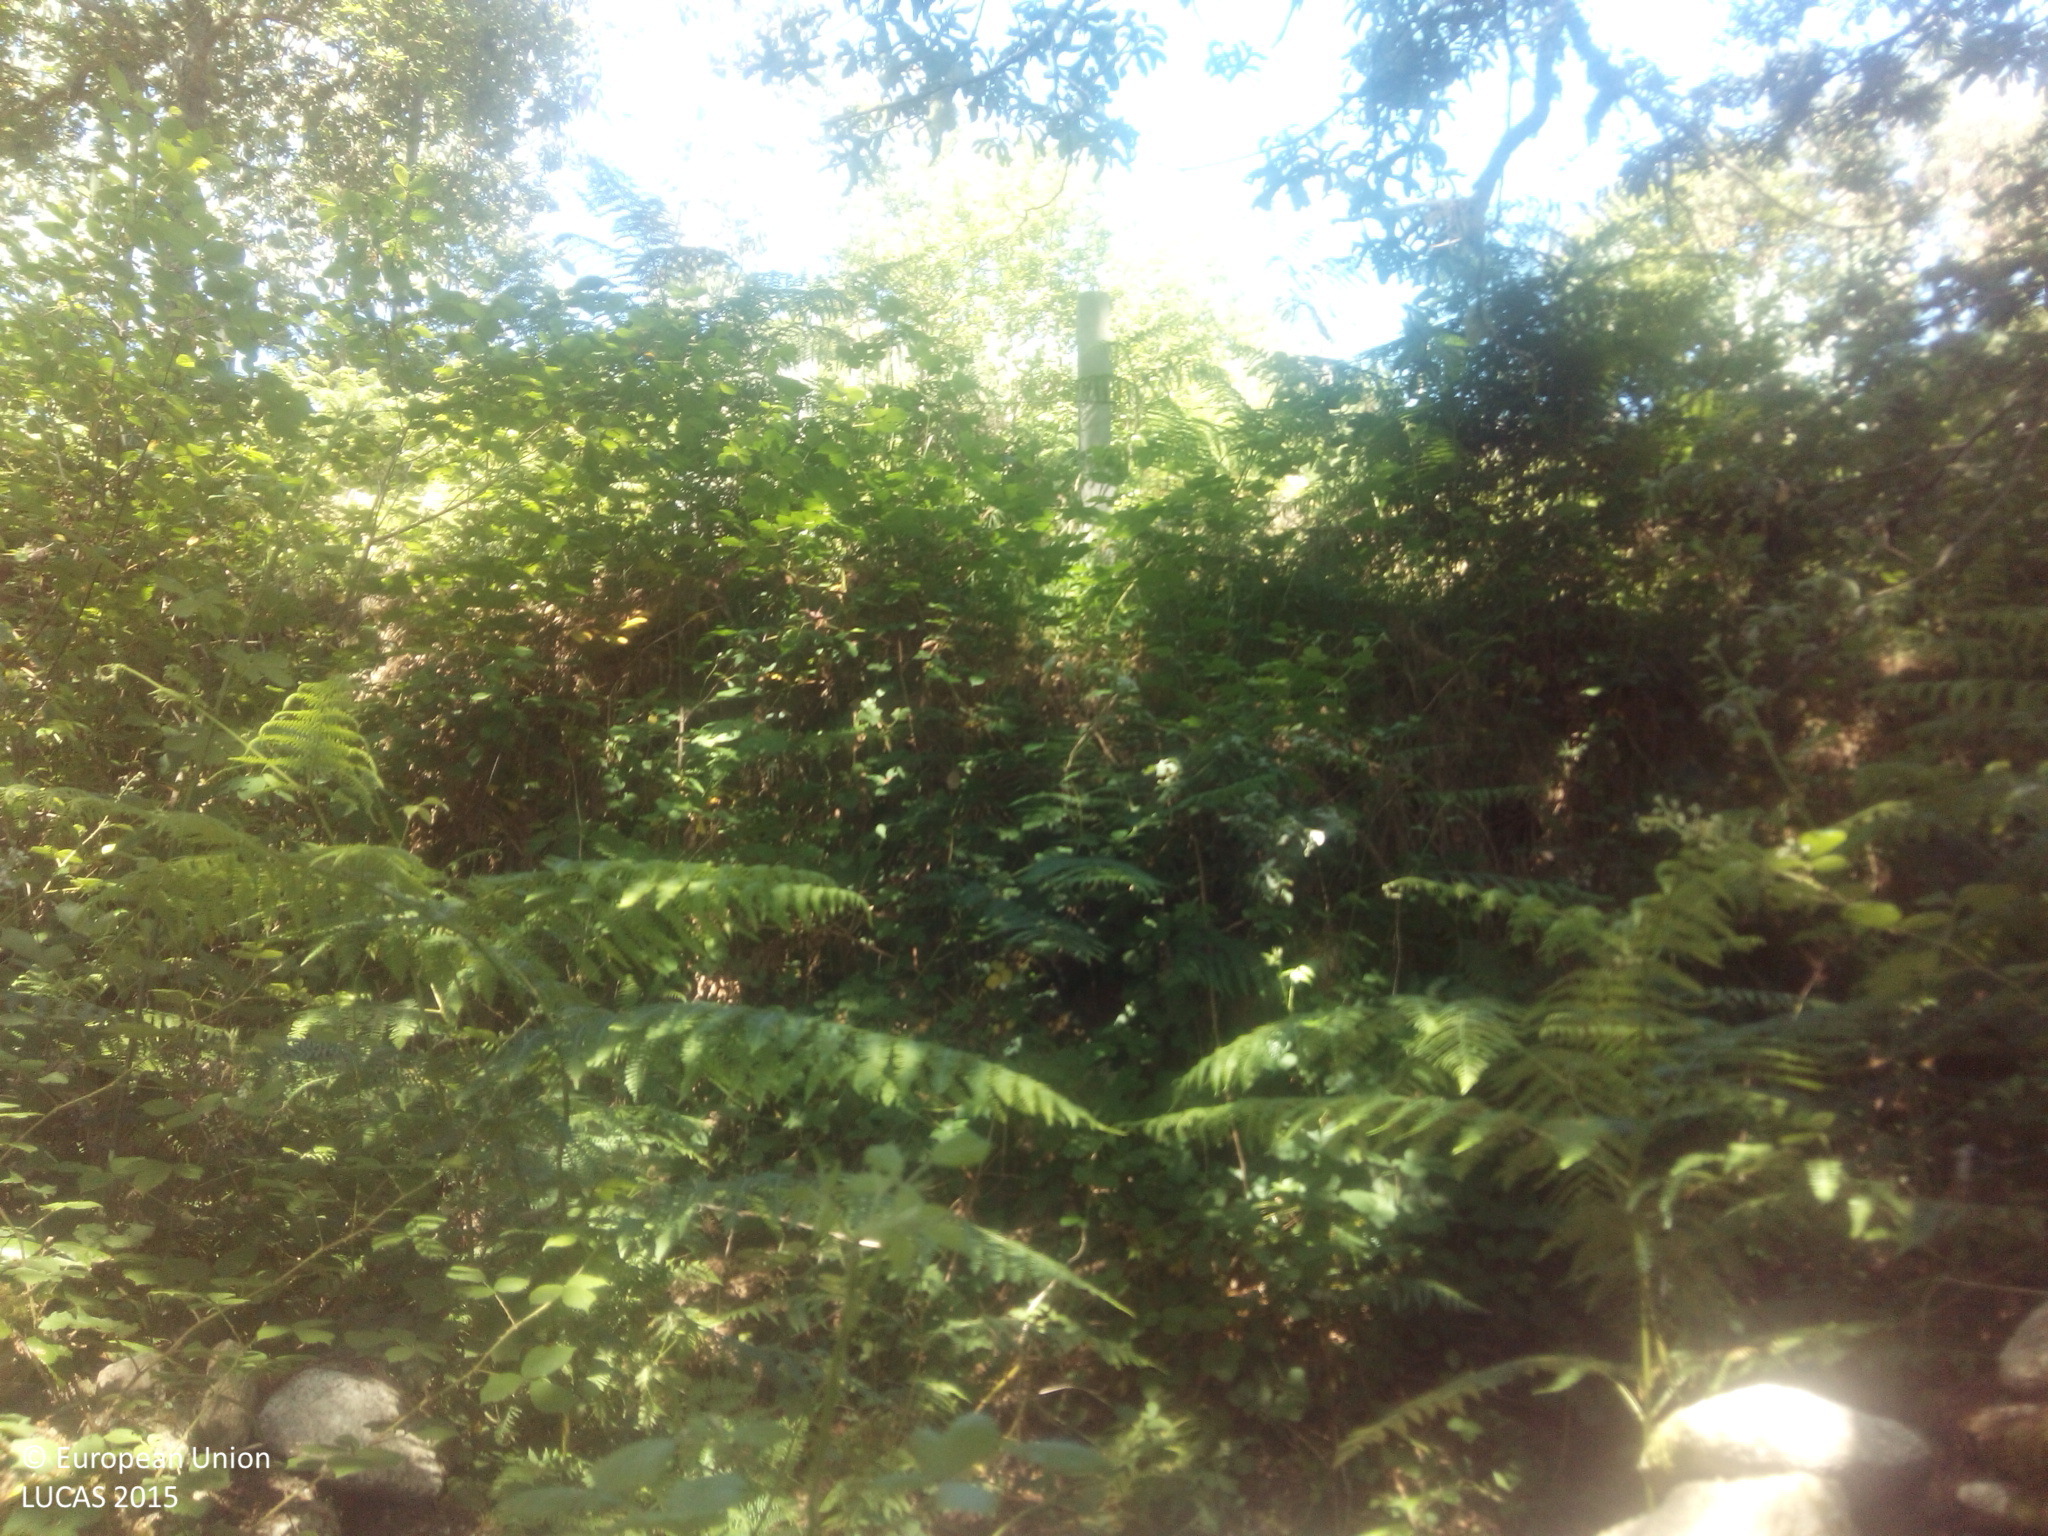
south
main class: Woodland
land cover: Broadleaved woodland
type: thermophilous deciduous forest
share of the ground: > 75 %
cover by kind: shrubs 75 %, broadleaved forest trees 20 %, coniferous forest trees 5 %
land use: Forestry
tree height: > 5 m
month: June
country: ES
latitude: 42.4357
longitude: -8.3637
